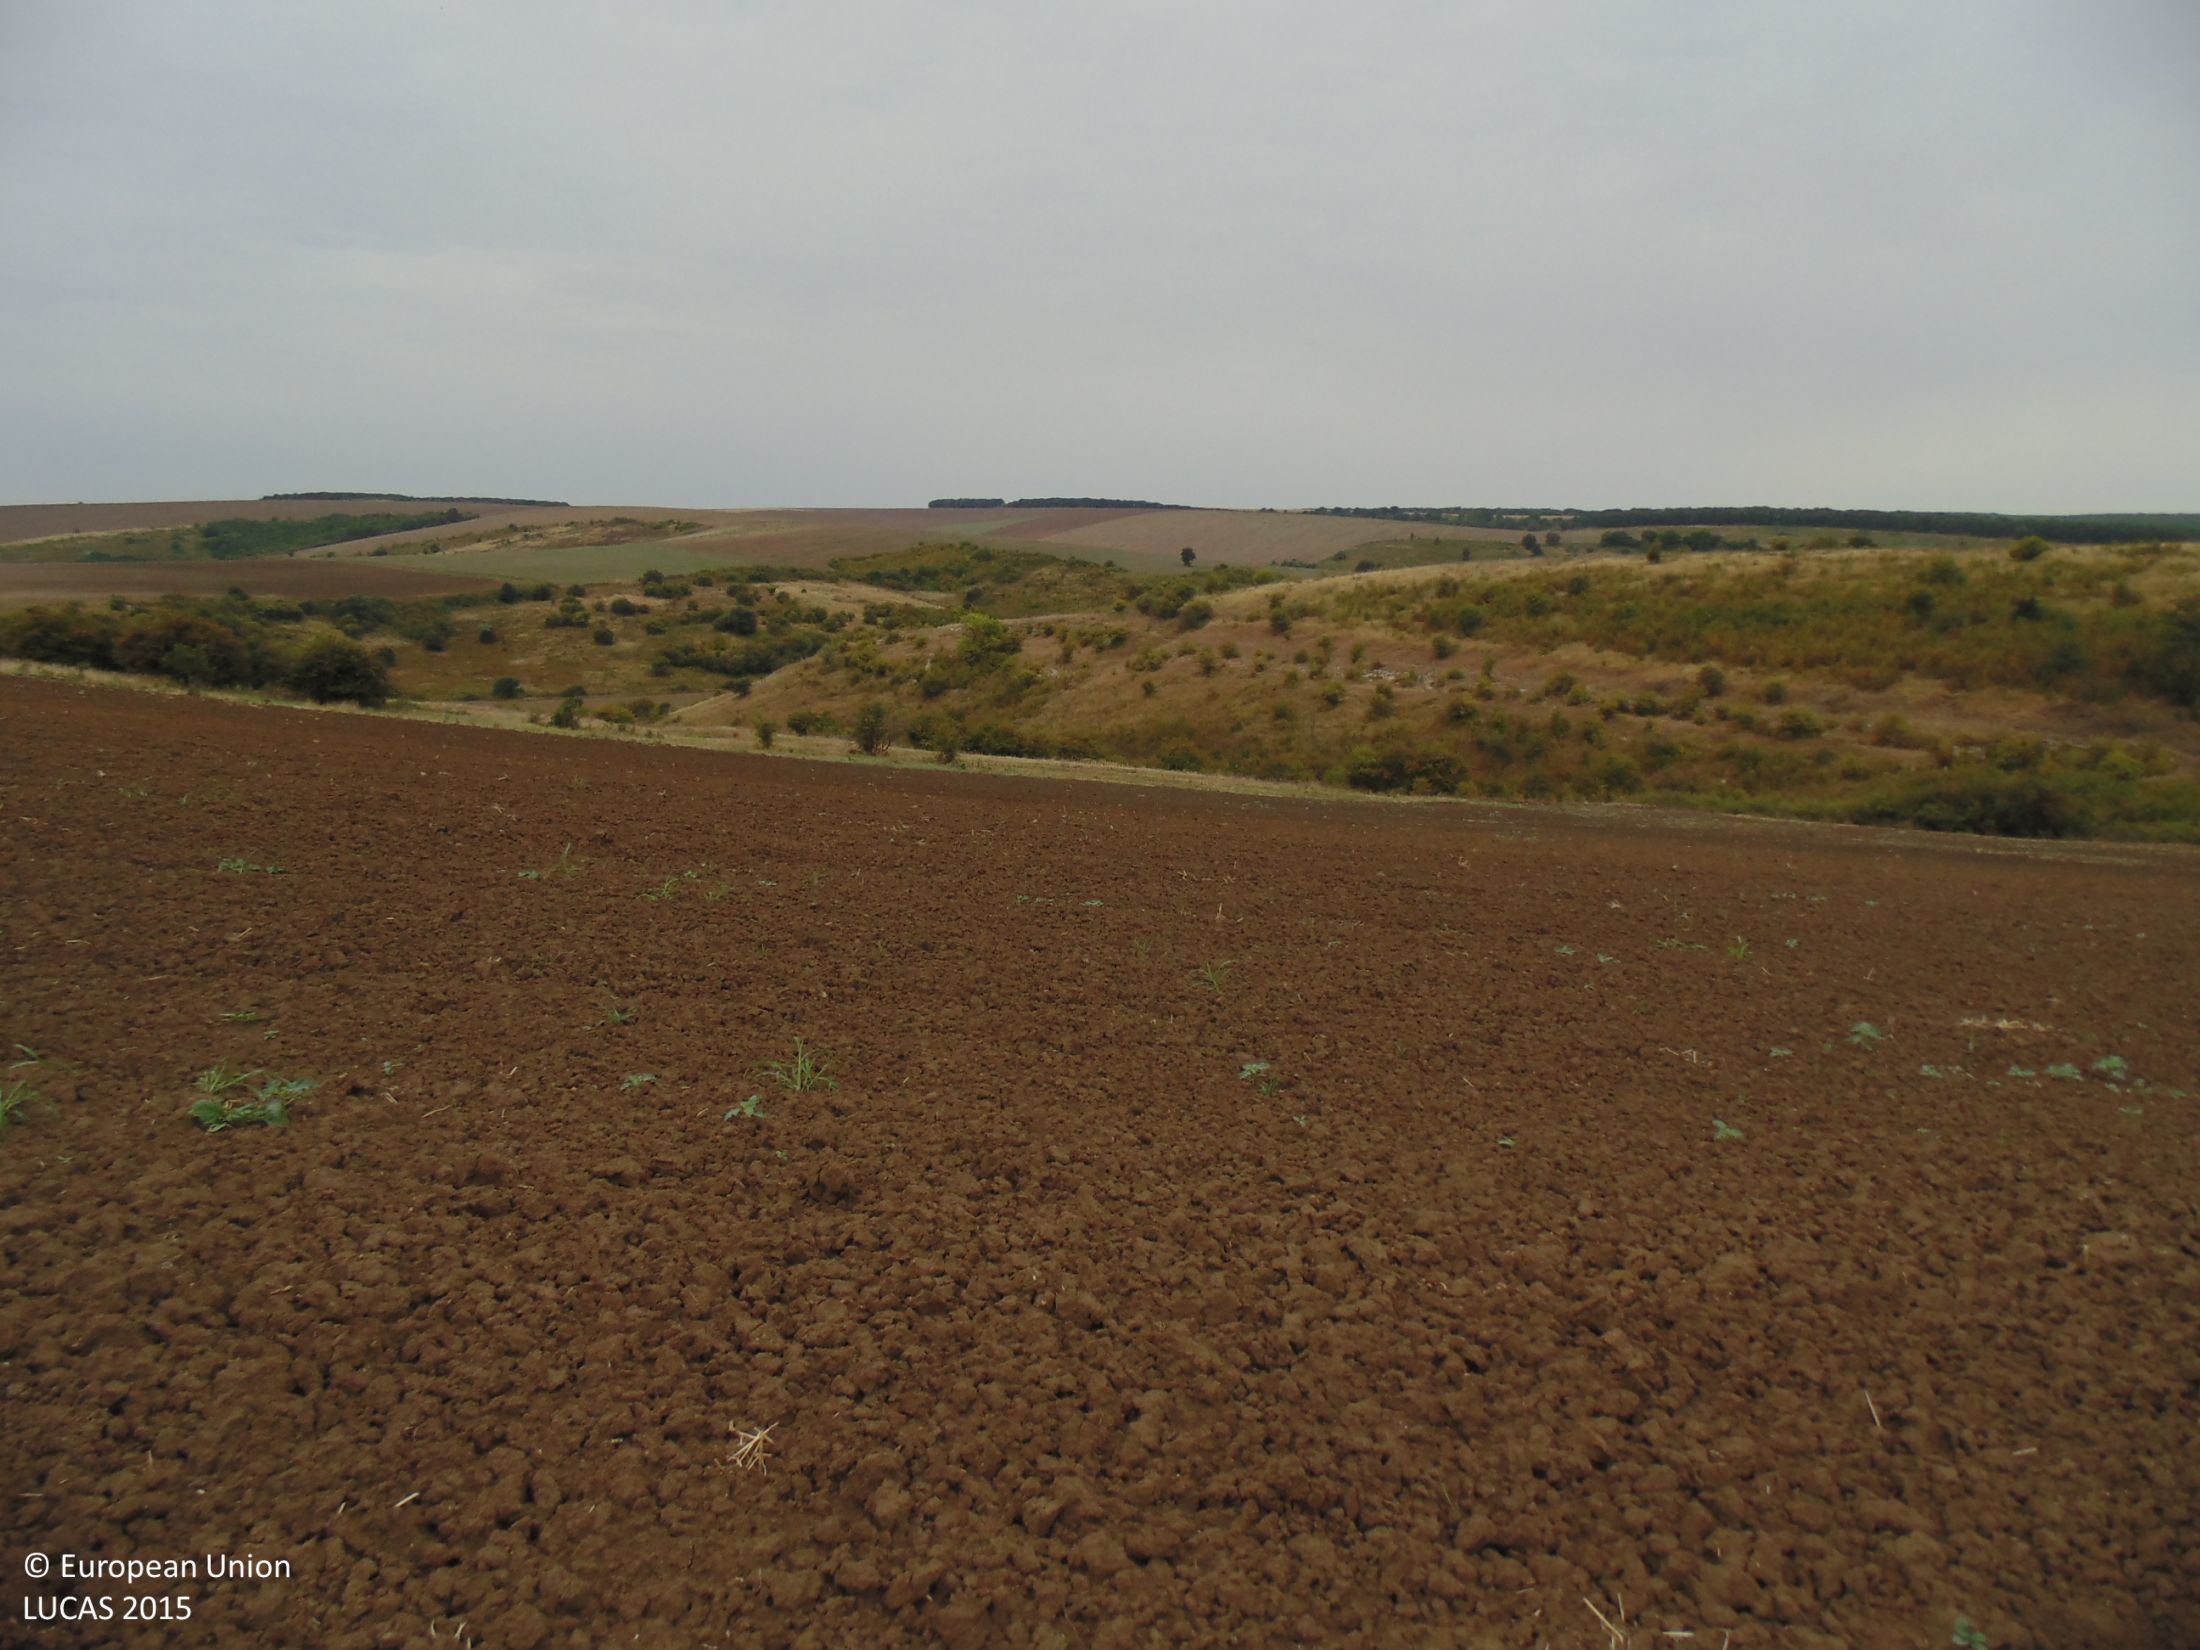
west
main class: Cropland
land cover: Common wheat
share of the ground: < 10 %
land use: Agriculture (excluding fallow land and kitchen gardens)
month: September
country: BG
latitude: 44.0258
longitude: 27.0810
